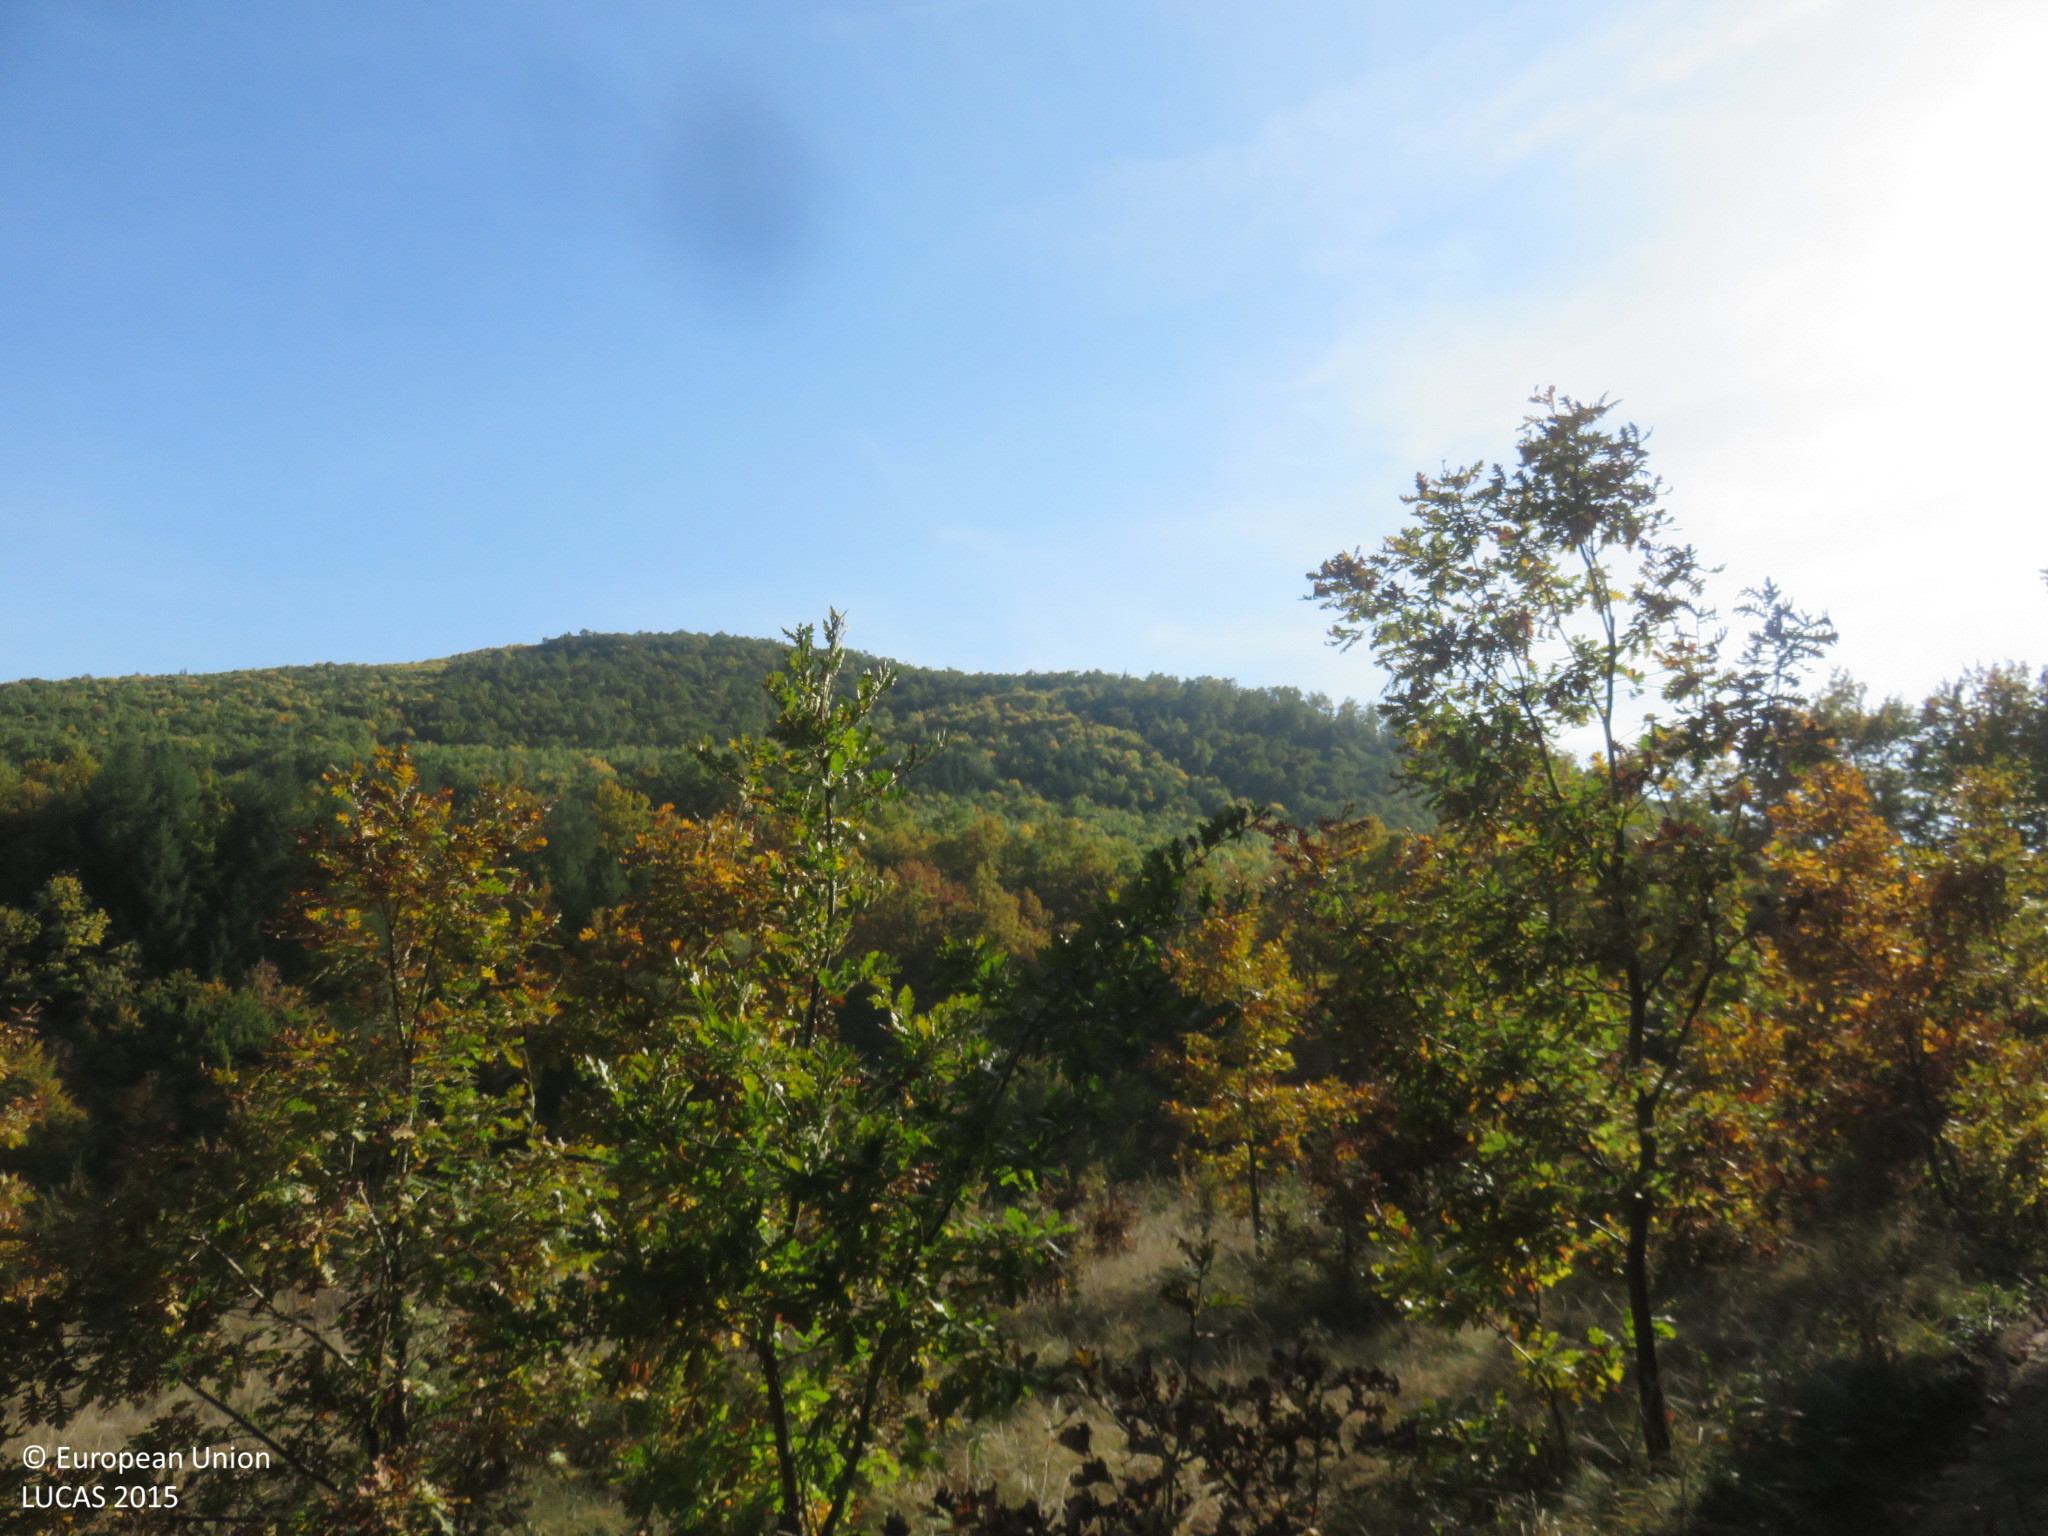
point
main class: Woodland
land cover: Broadleaved woodland
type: mesophytic deciduous forest
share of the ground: > 75 %
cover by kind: broadleaved forest trees 90 %, coniferous forest trees 10 %
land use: Forestry
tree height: > 5 m
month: October
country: BG
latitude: 42.9552
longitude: 24.7828
